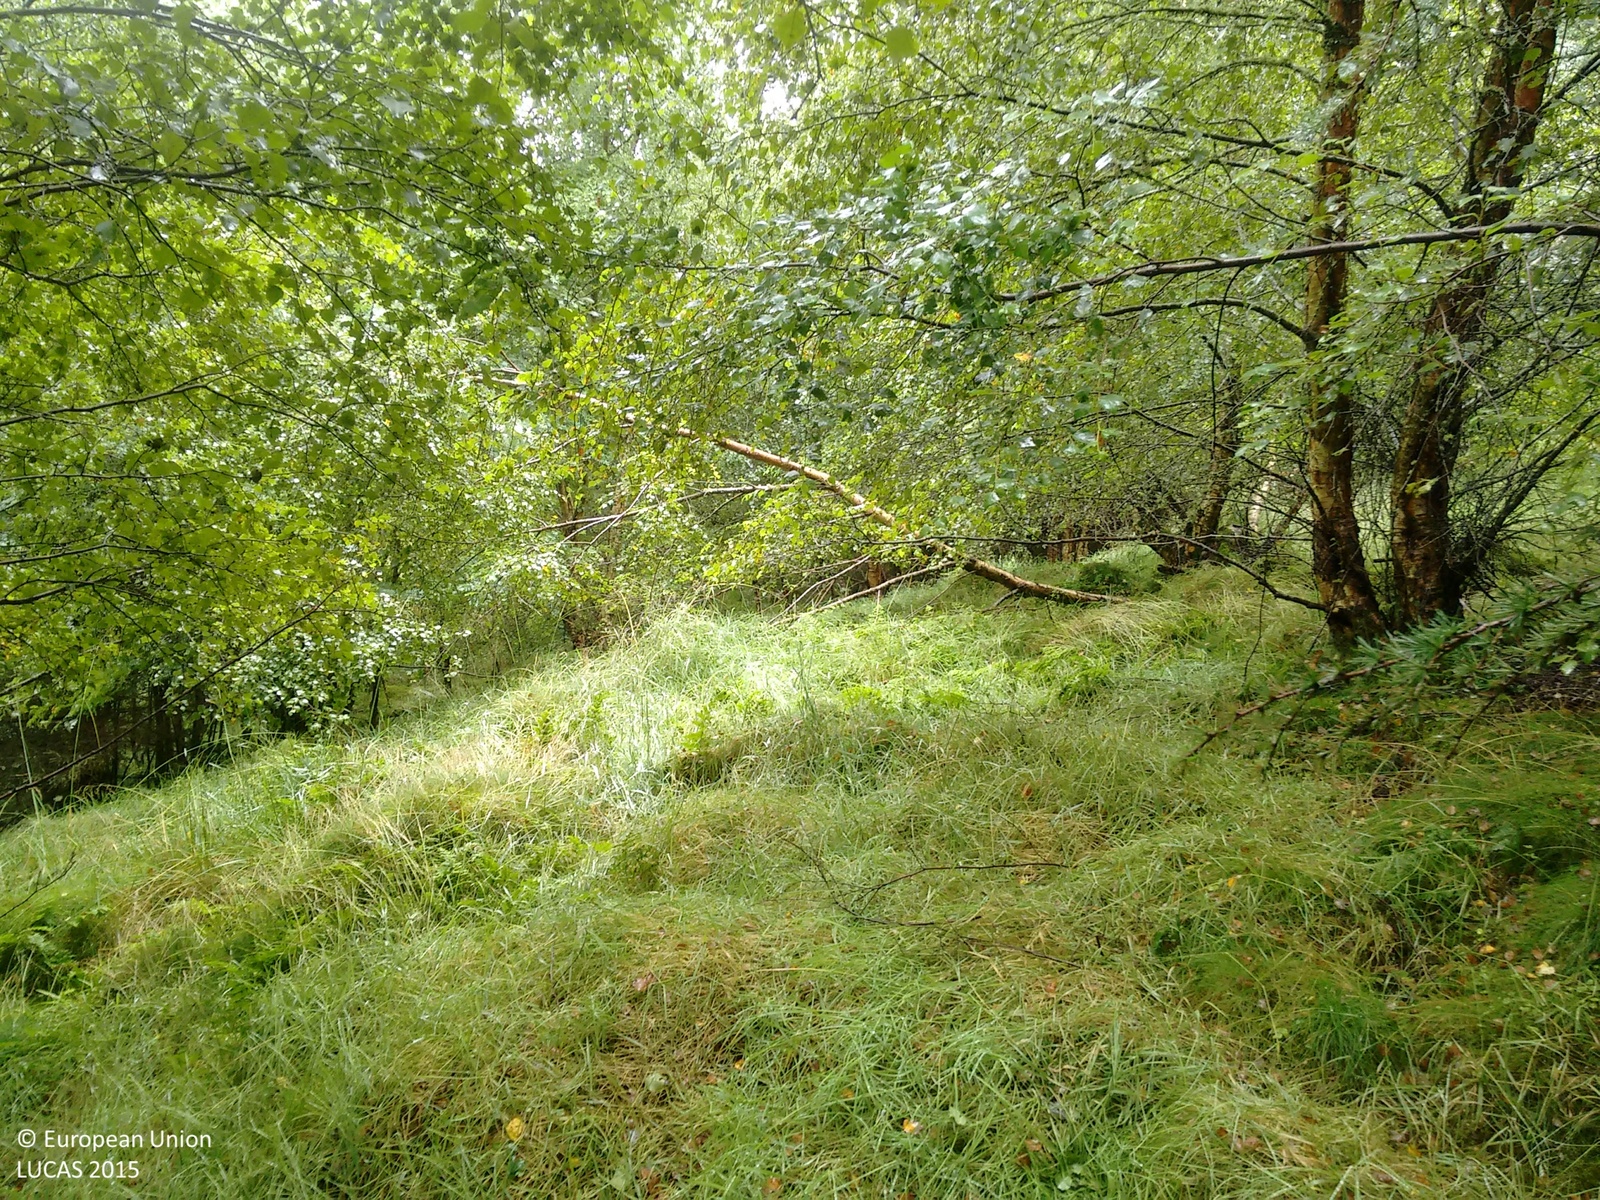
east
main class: Woodland
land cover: Spruce dominated mixed woodland
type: exotic forest
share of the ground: > 75 %
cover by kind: coniferous forest trees 60 %, broadleaved forest trees 35 %, herbaceous plants 5 %
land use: Forestry
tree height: > 5 m
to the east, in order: Spruce dominated mixed woodland; Ditches and canals; Spruce dominated mixed woodland; Tracks; Broadleaved woodland; Dry stone walls; Fences; Grassland without tree/shrub cover; Fences; Grass margins; Inland fresh running water; Lines of trees; Grassland without tree/shrub cover; Fences; Grassland without tree/shrub cover; Dry stone walls; Fences; Grassland without tree/shrub cover; Fences; Grassland without tree/shrub cover
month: August
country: GB
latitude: 57.4369
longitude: -2.2599
